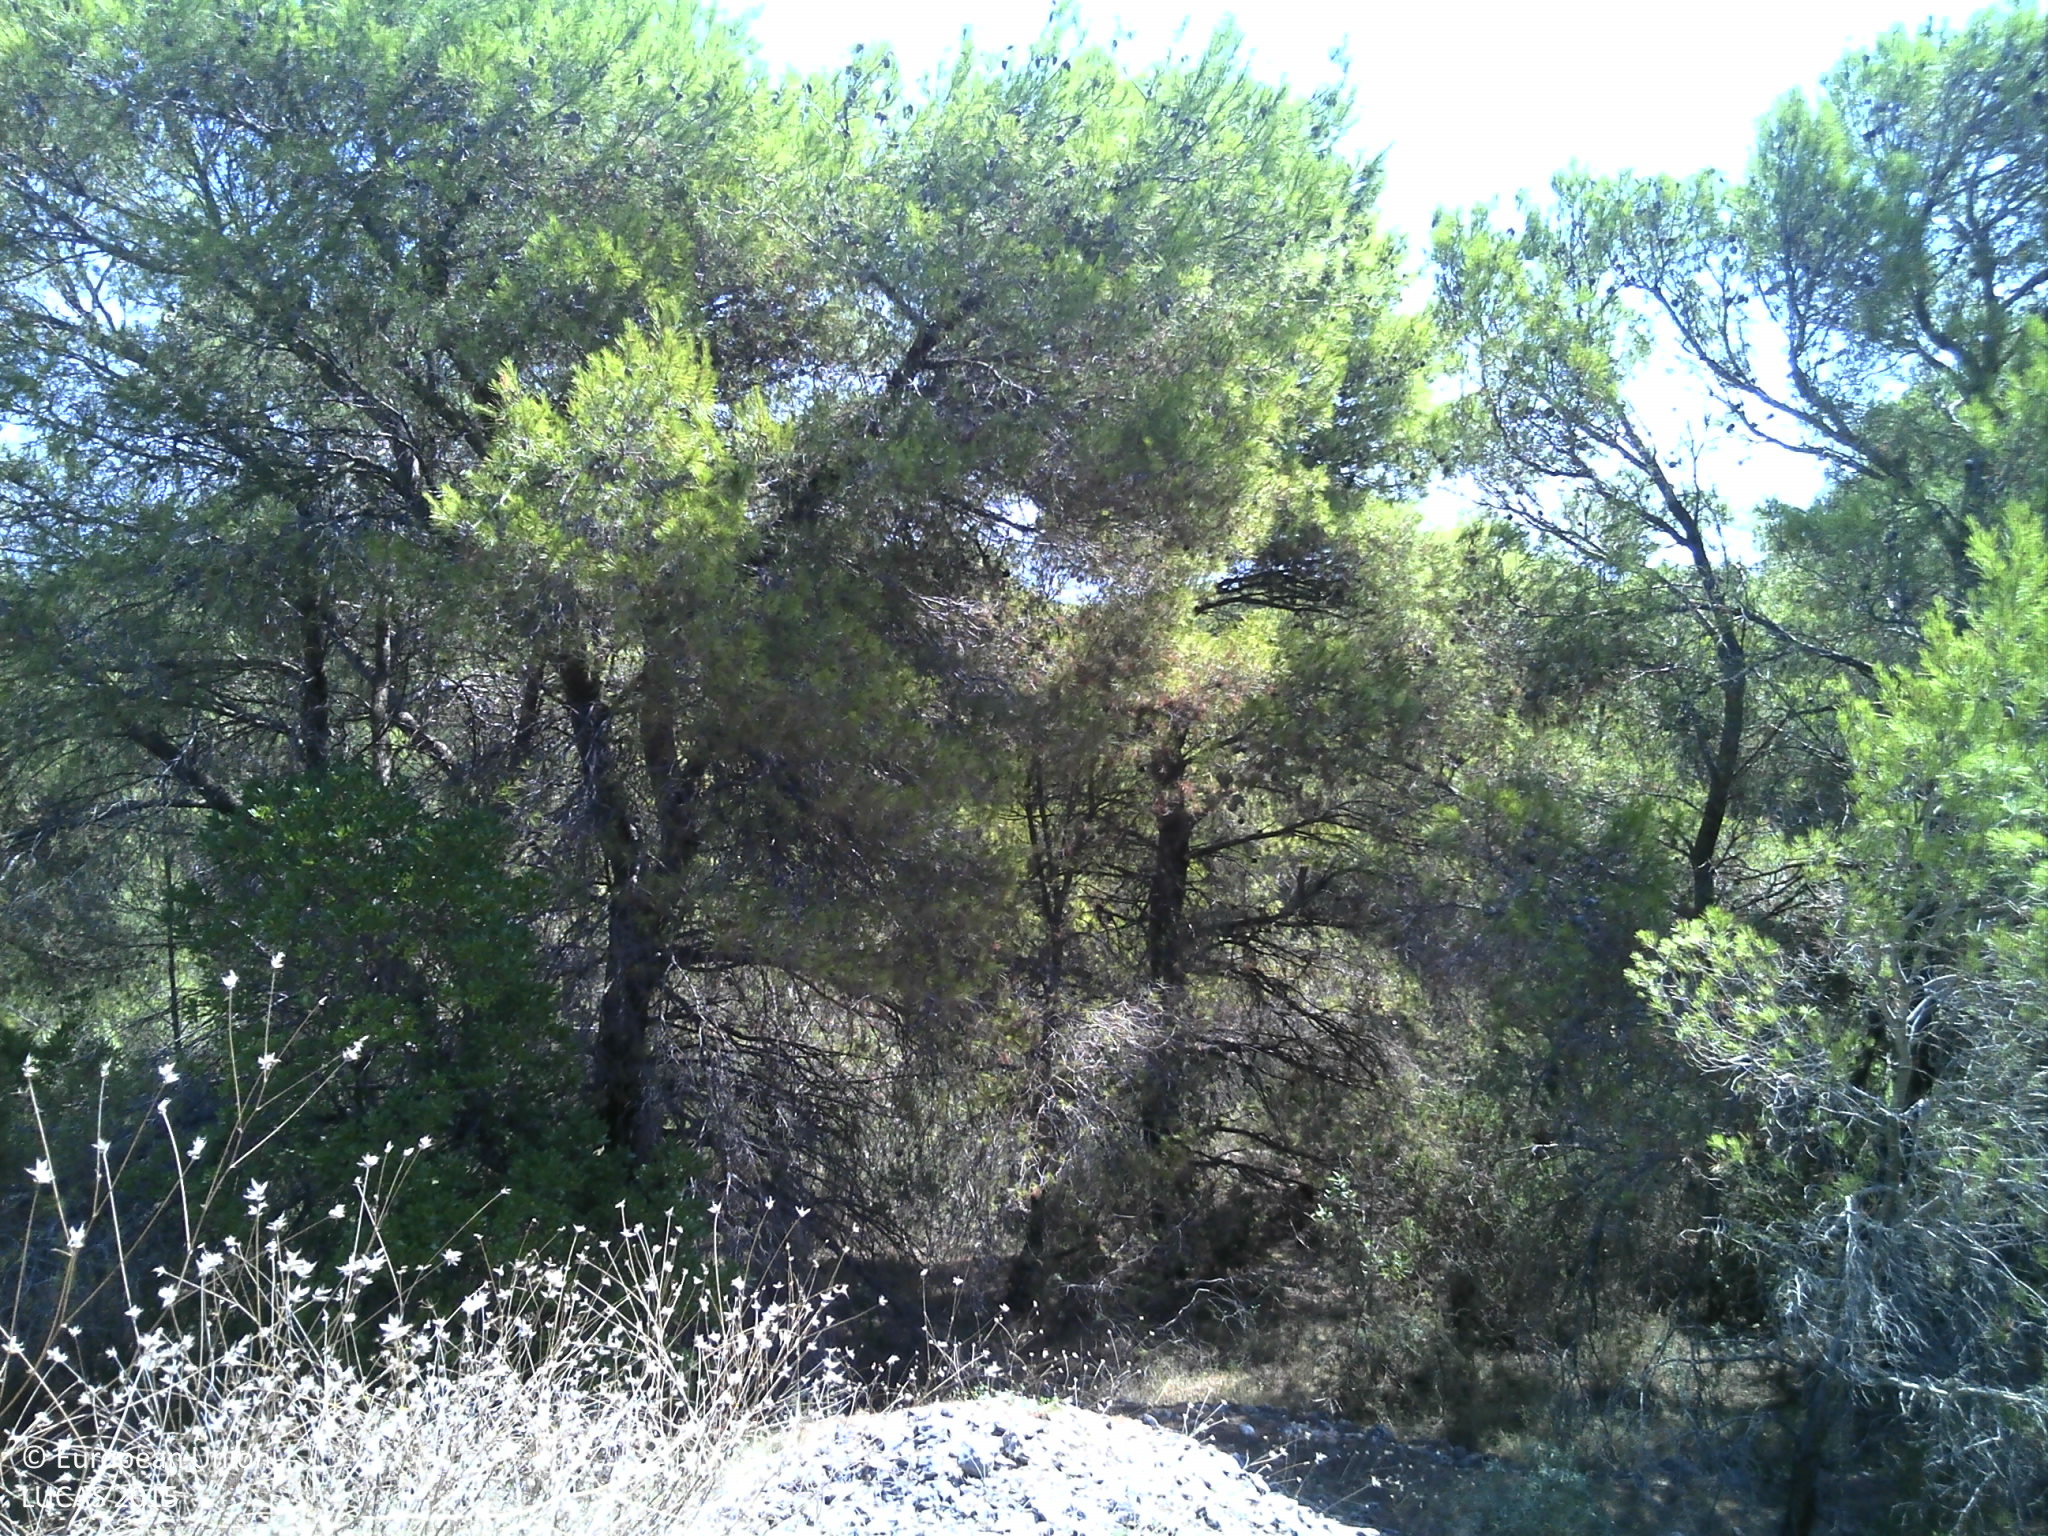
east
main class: Woodland
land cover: Pine dominated coniferous woodland
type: coniferous forest of the mediterranean region
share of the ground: > 75 %
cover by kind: coniferous forest trees 75 %, shrubs 10 %, herbaceous plants 10 %, unconsolidated bare surface 5 %
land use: Semi-natural and natural areas not in use
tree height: > 5 m
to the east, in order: Pine dominated coniferous woodland; Dry stone walls; Pine dominated coniferous woodland; Tracks; Shrubland with sparse tree cover; Olive groves; Shrubland with sparse tree cover; Dry stone walls; Shrubland with sparse tree cover; Pine dominated coniferous woodland
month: August
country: HR
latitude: 43.0276
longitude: 16.1614
